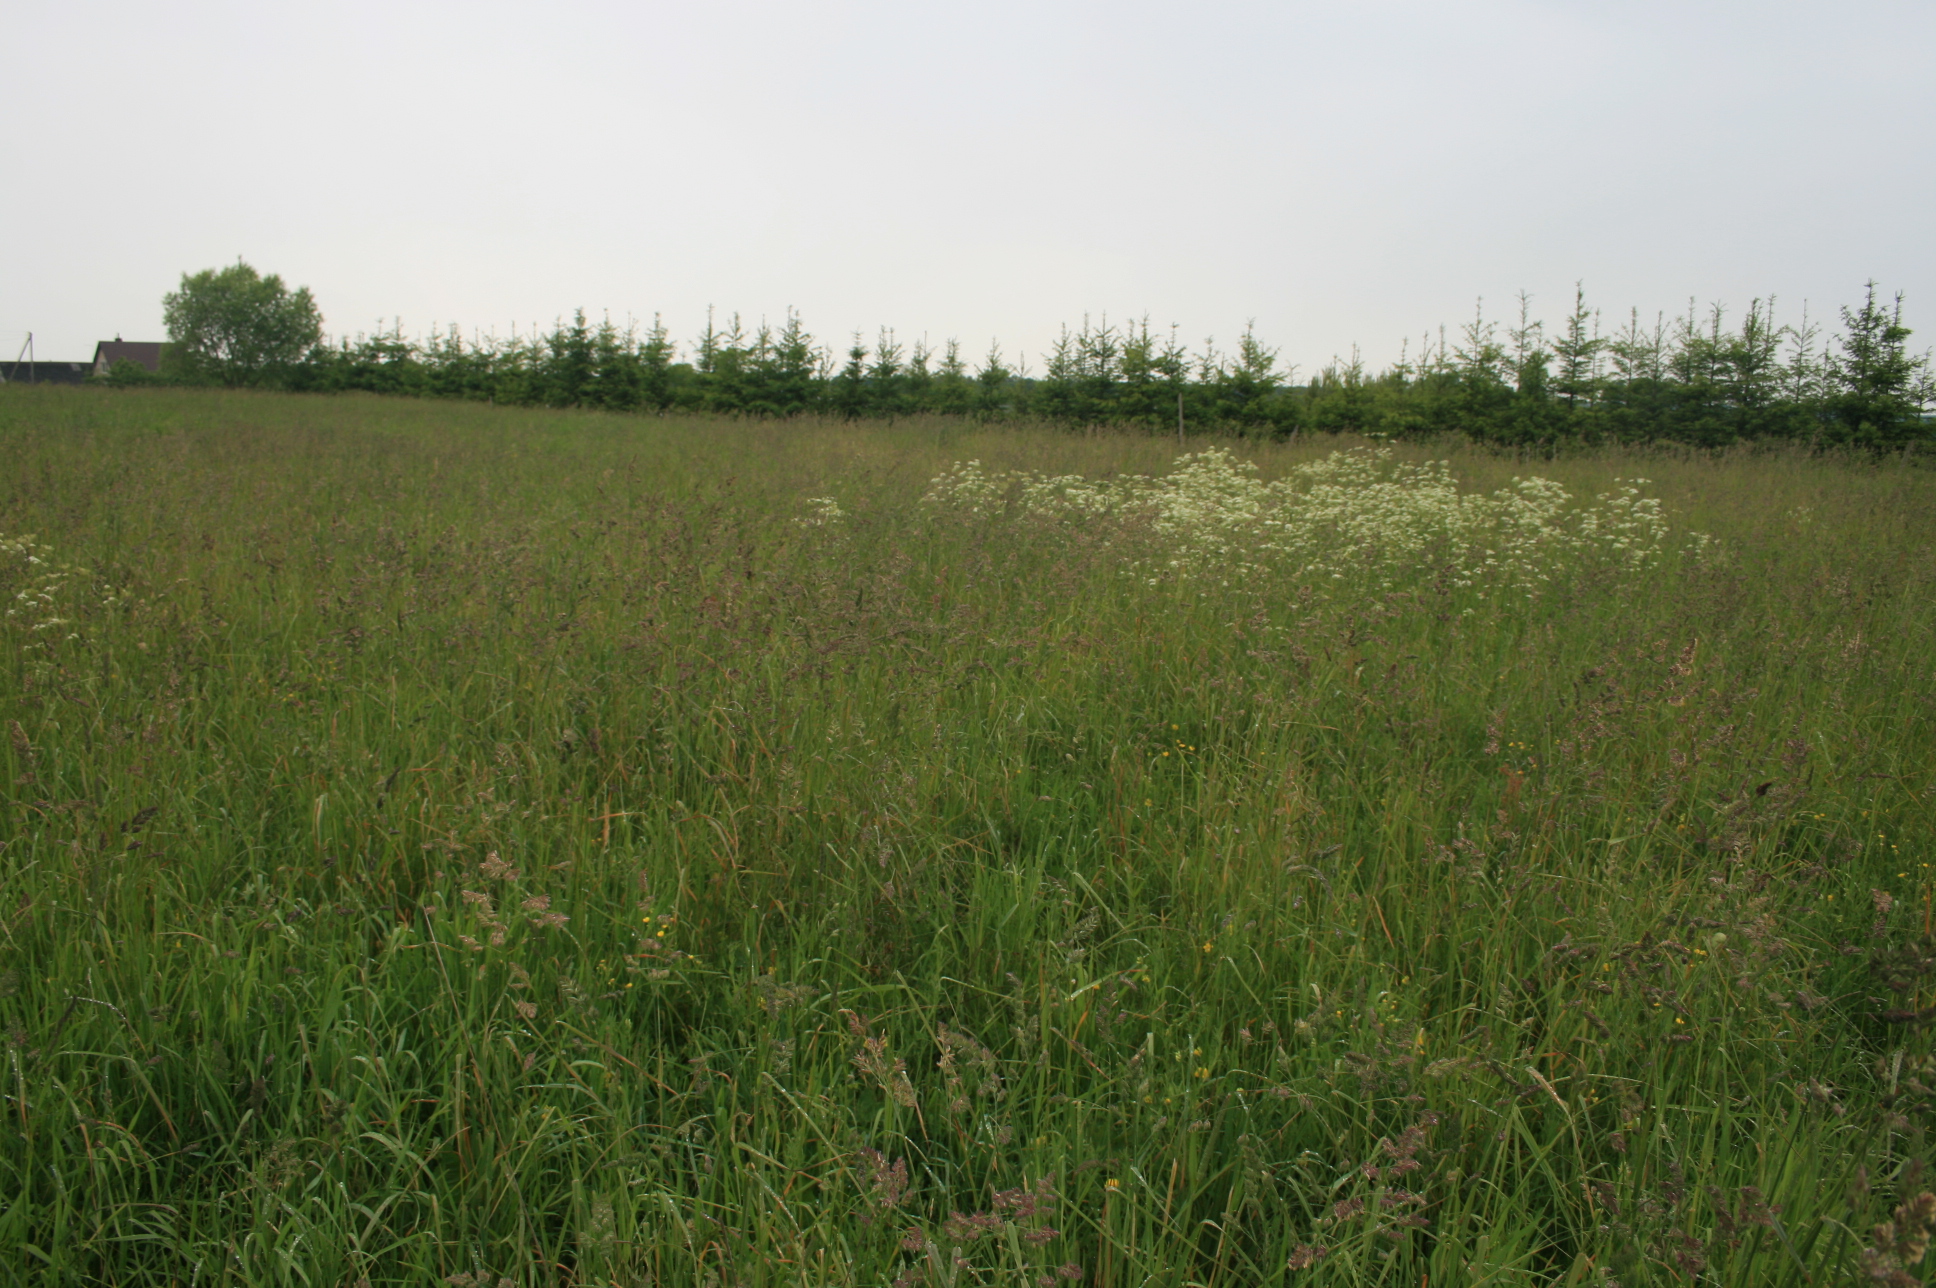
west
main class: Grassland
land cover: Grassland without tree/shrub cover
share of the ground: > 75 %
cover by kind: herbaceous plants 100 %
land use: Agriculture (excluding fallow land and kitchen gardens)
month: June
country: LT
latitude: 55.4819
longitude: 22.3213
